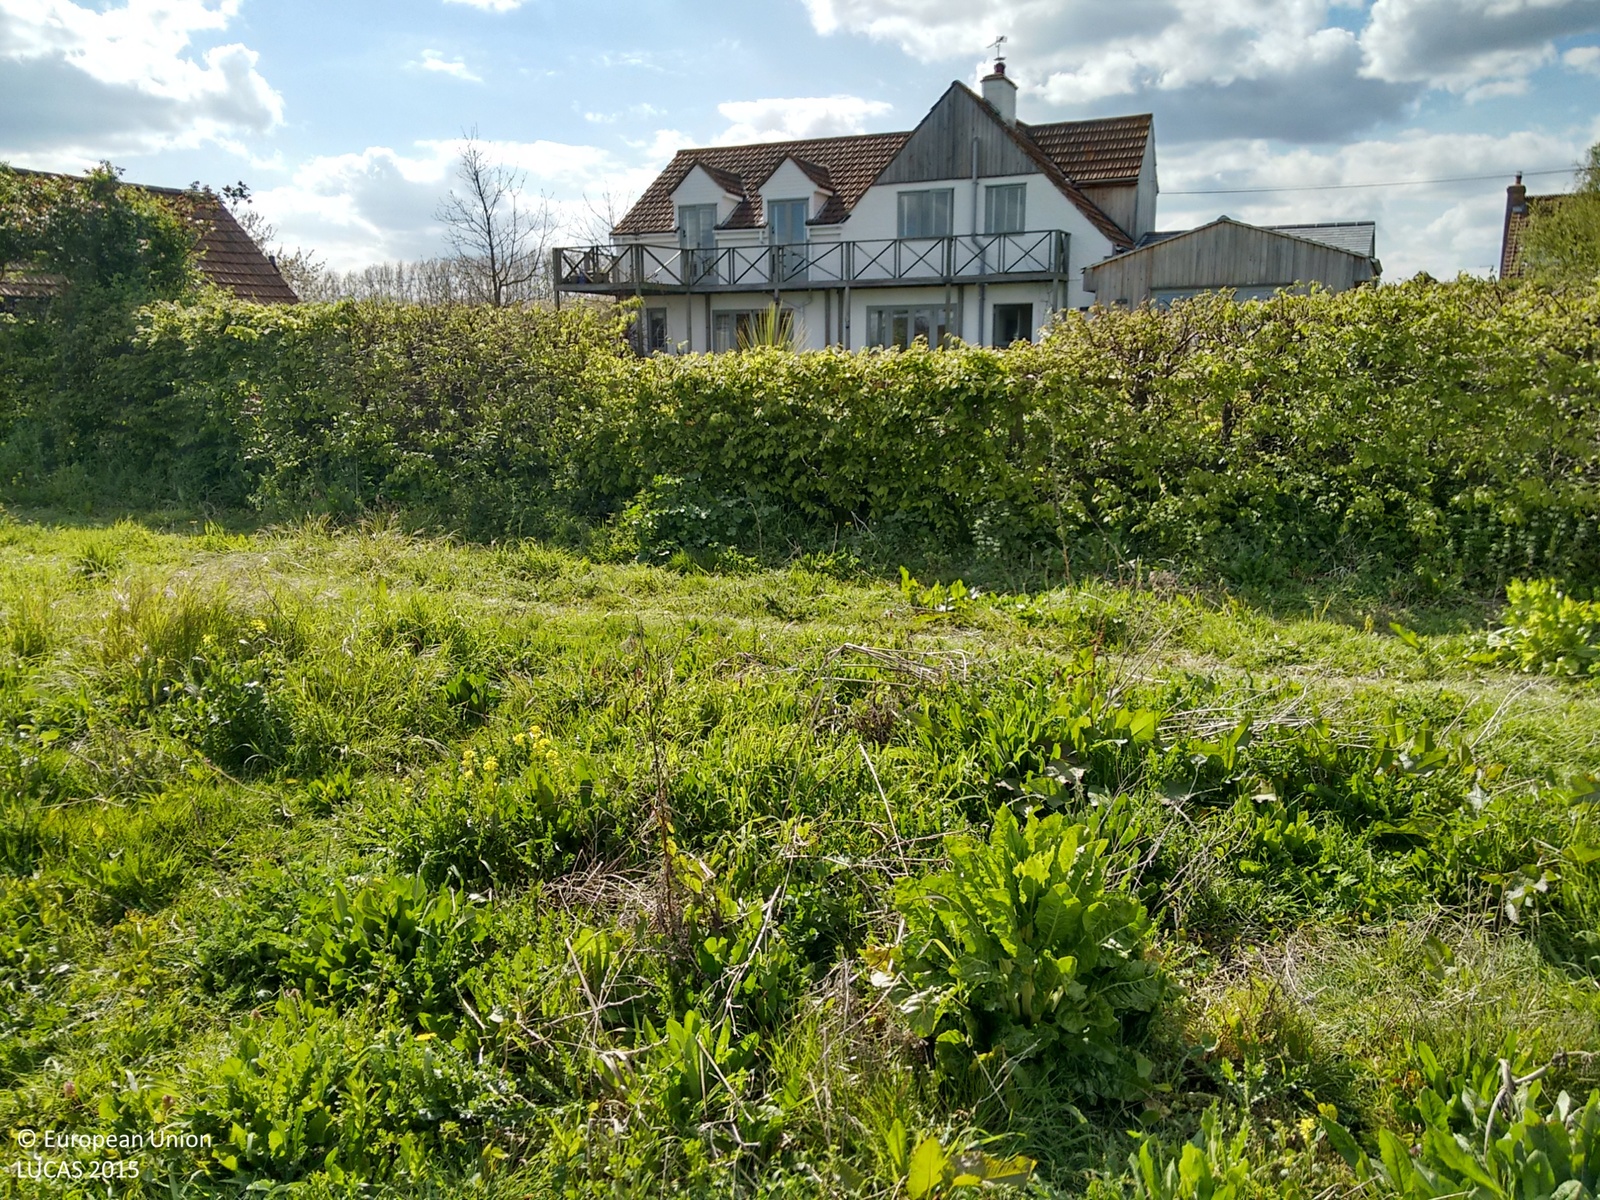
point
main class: Grassland
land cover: Grassland without tree/shrub cover
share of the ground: > 75 %
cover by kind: herbaceous plants 100 %
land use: Residential
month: April
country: GB
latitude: 51.3541
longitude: 0.6252
